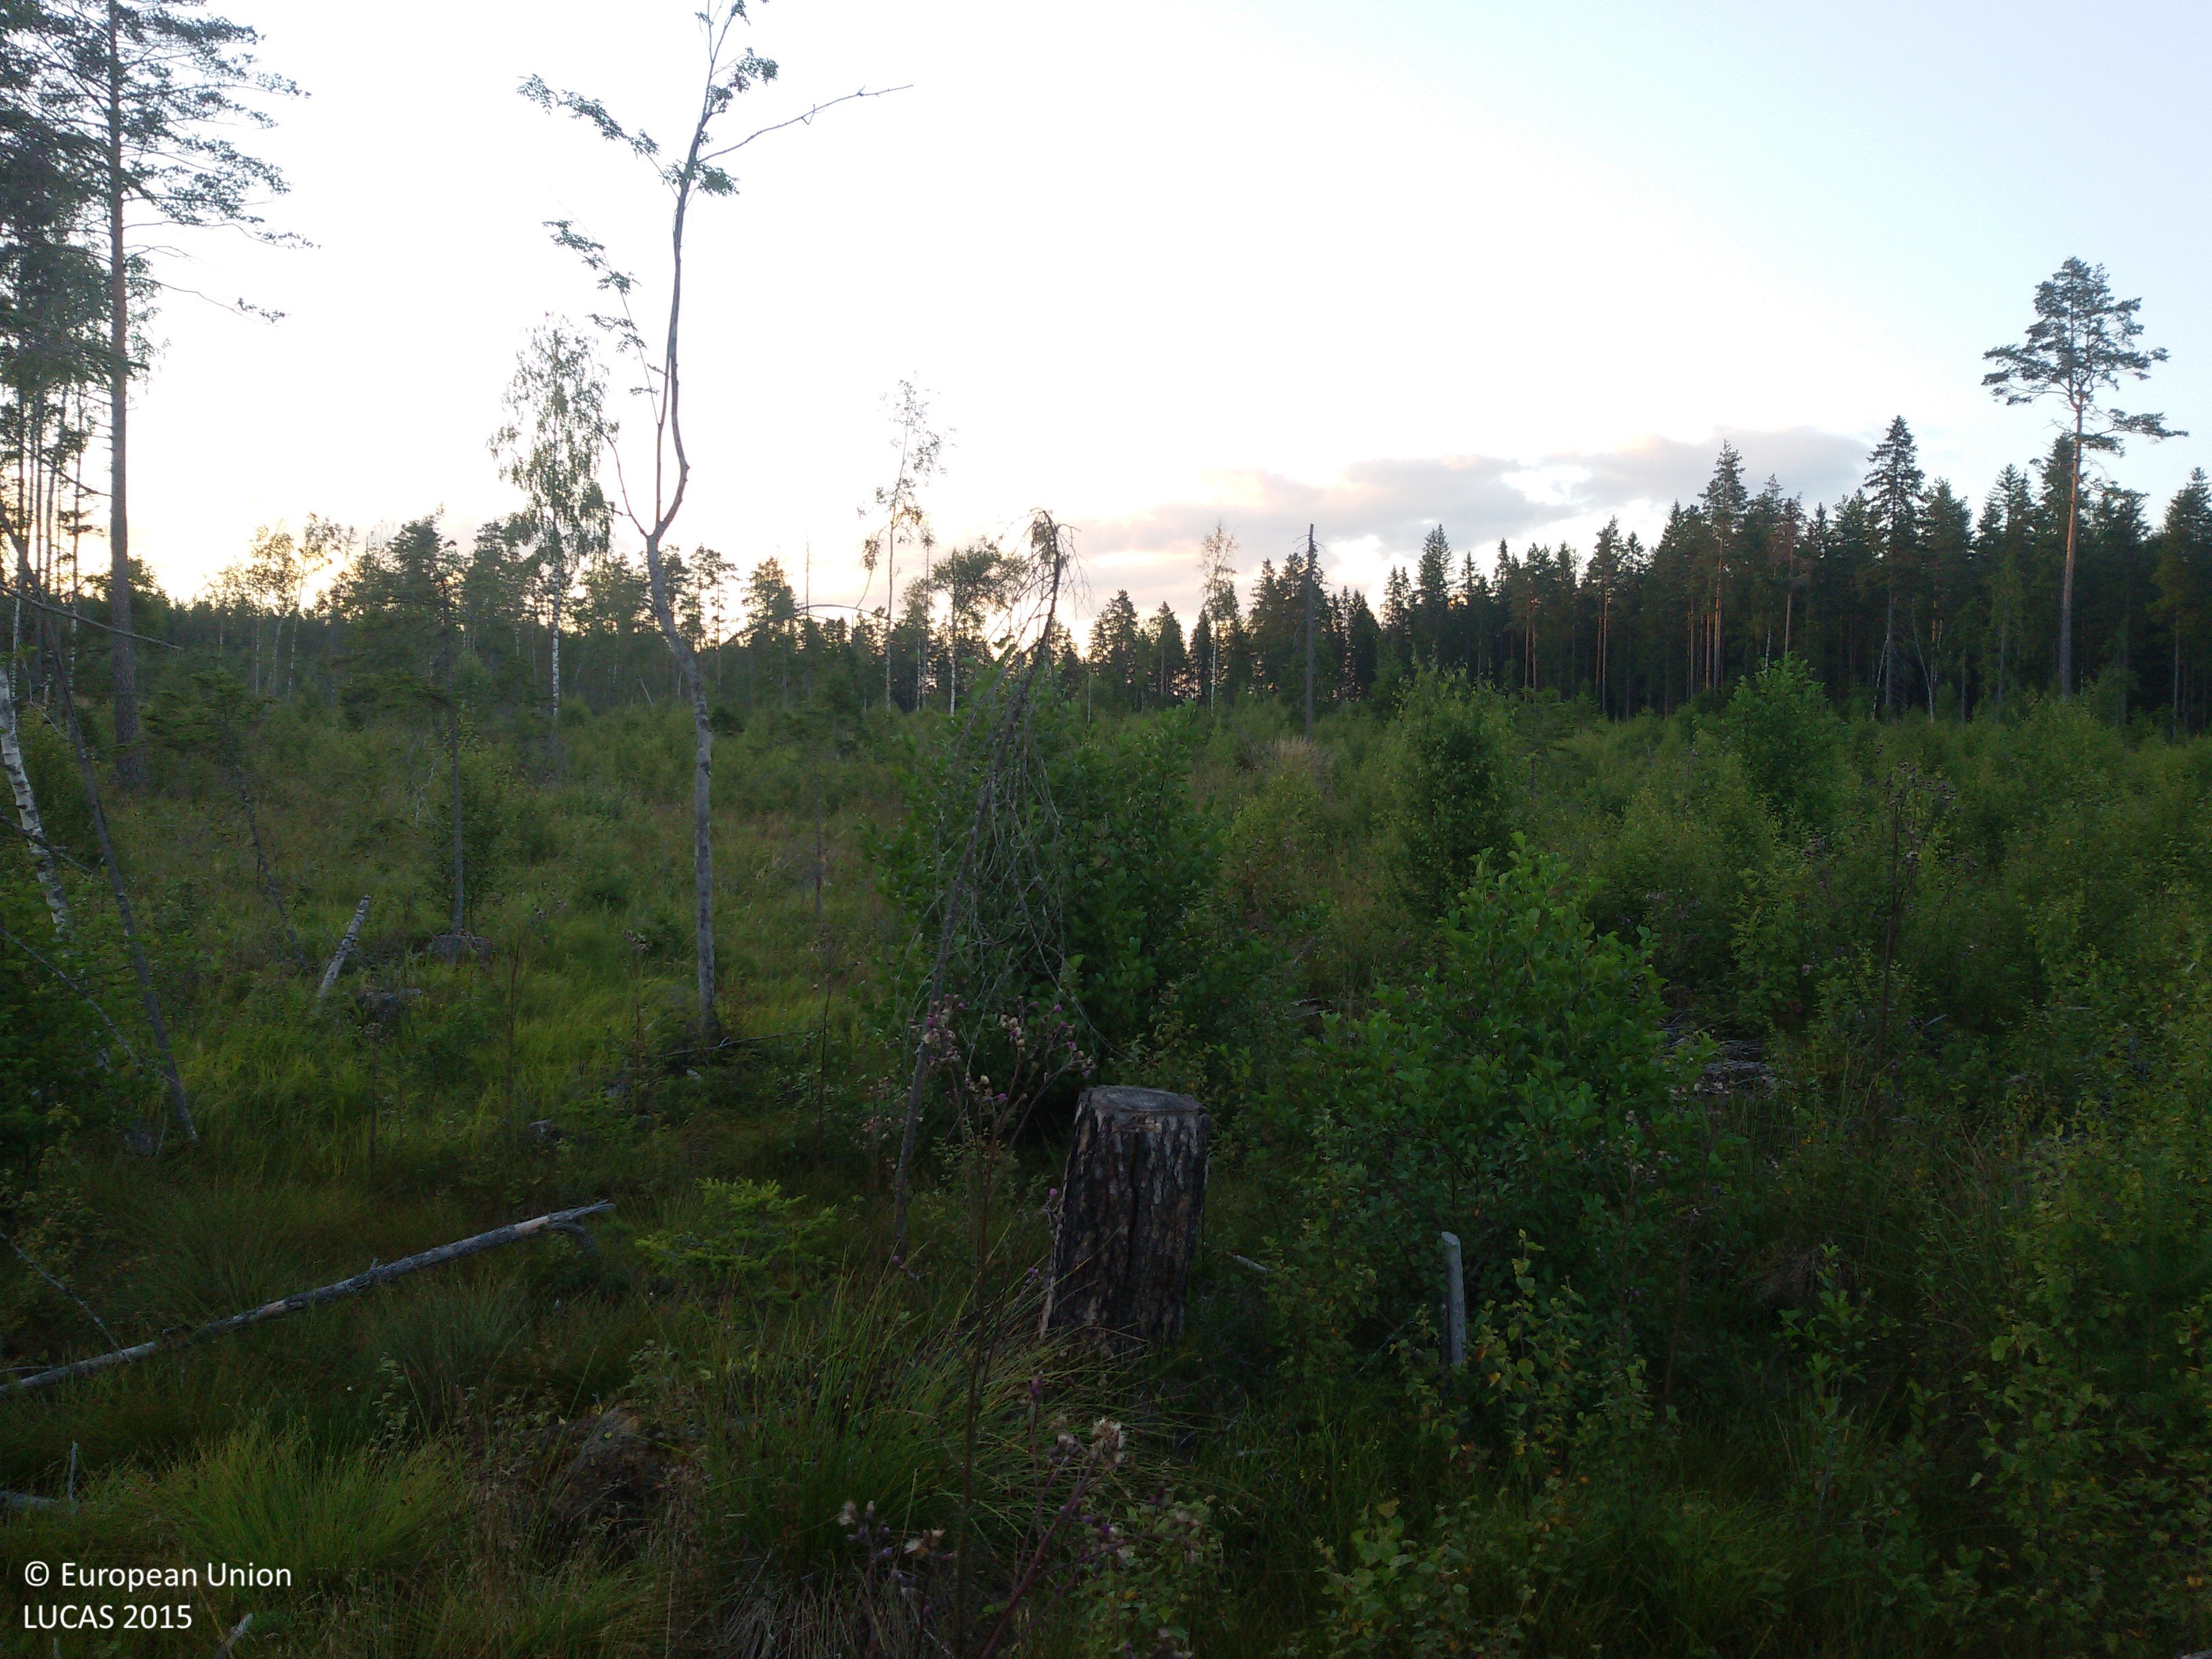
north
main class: Woodland
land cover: Broadleaved woodland
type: boreal forest
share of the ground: 50 - 75 %
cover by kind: broadleaved forest trees 50 %, herbaceous plants 40 %, coniferous forest trees 10 %
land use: Forestry
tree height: < 5 m
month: August
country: SE
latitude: 60.6412
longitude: 16.5890
